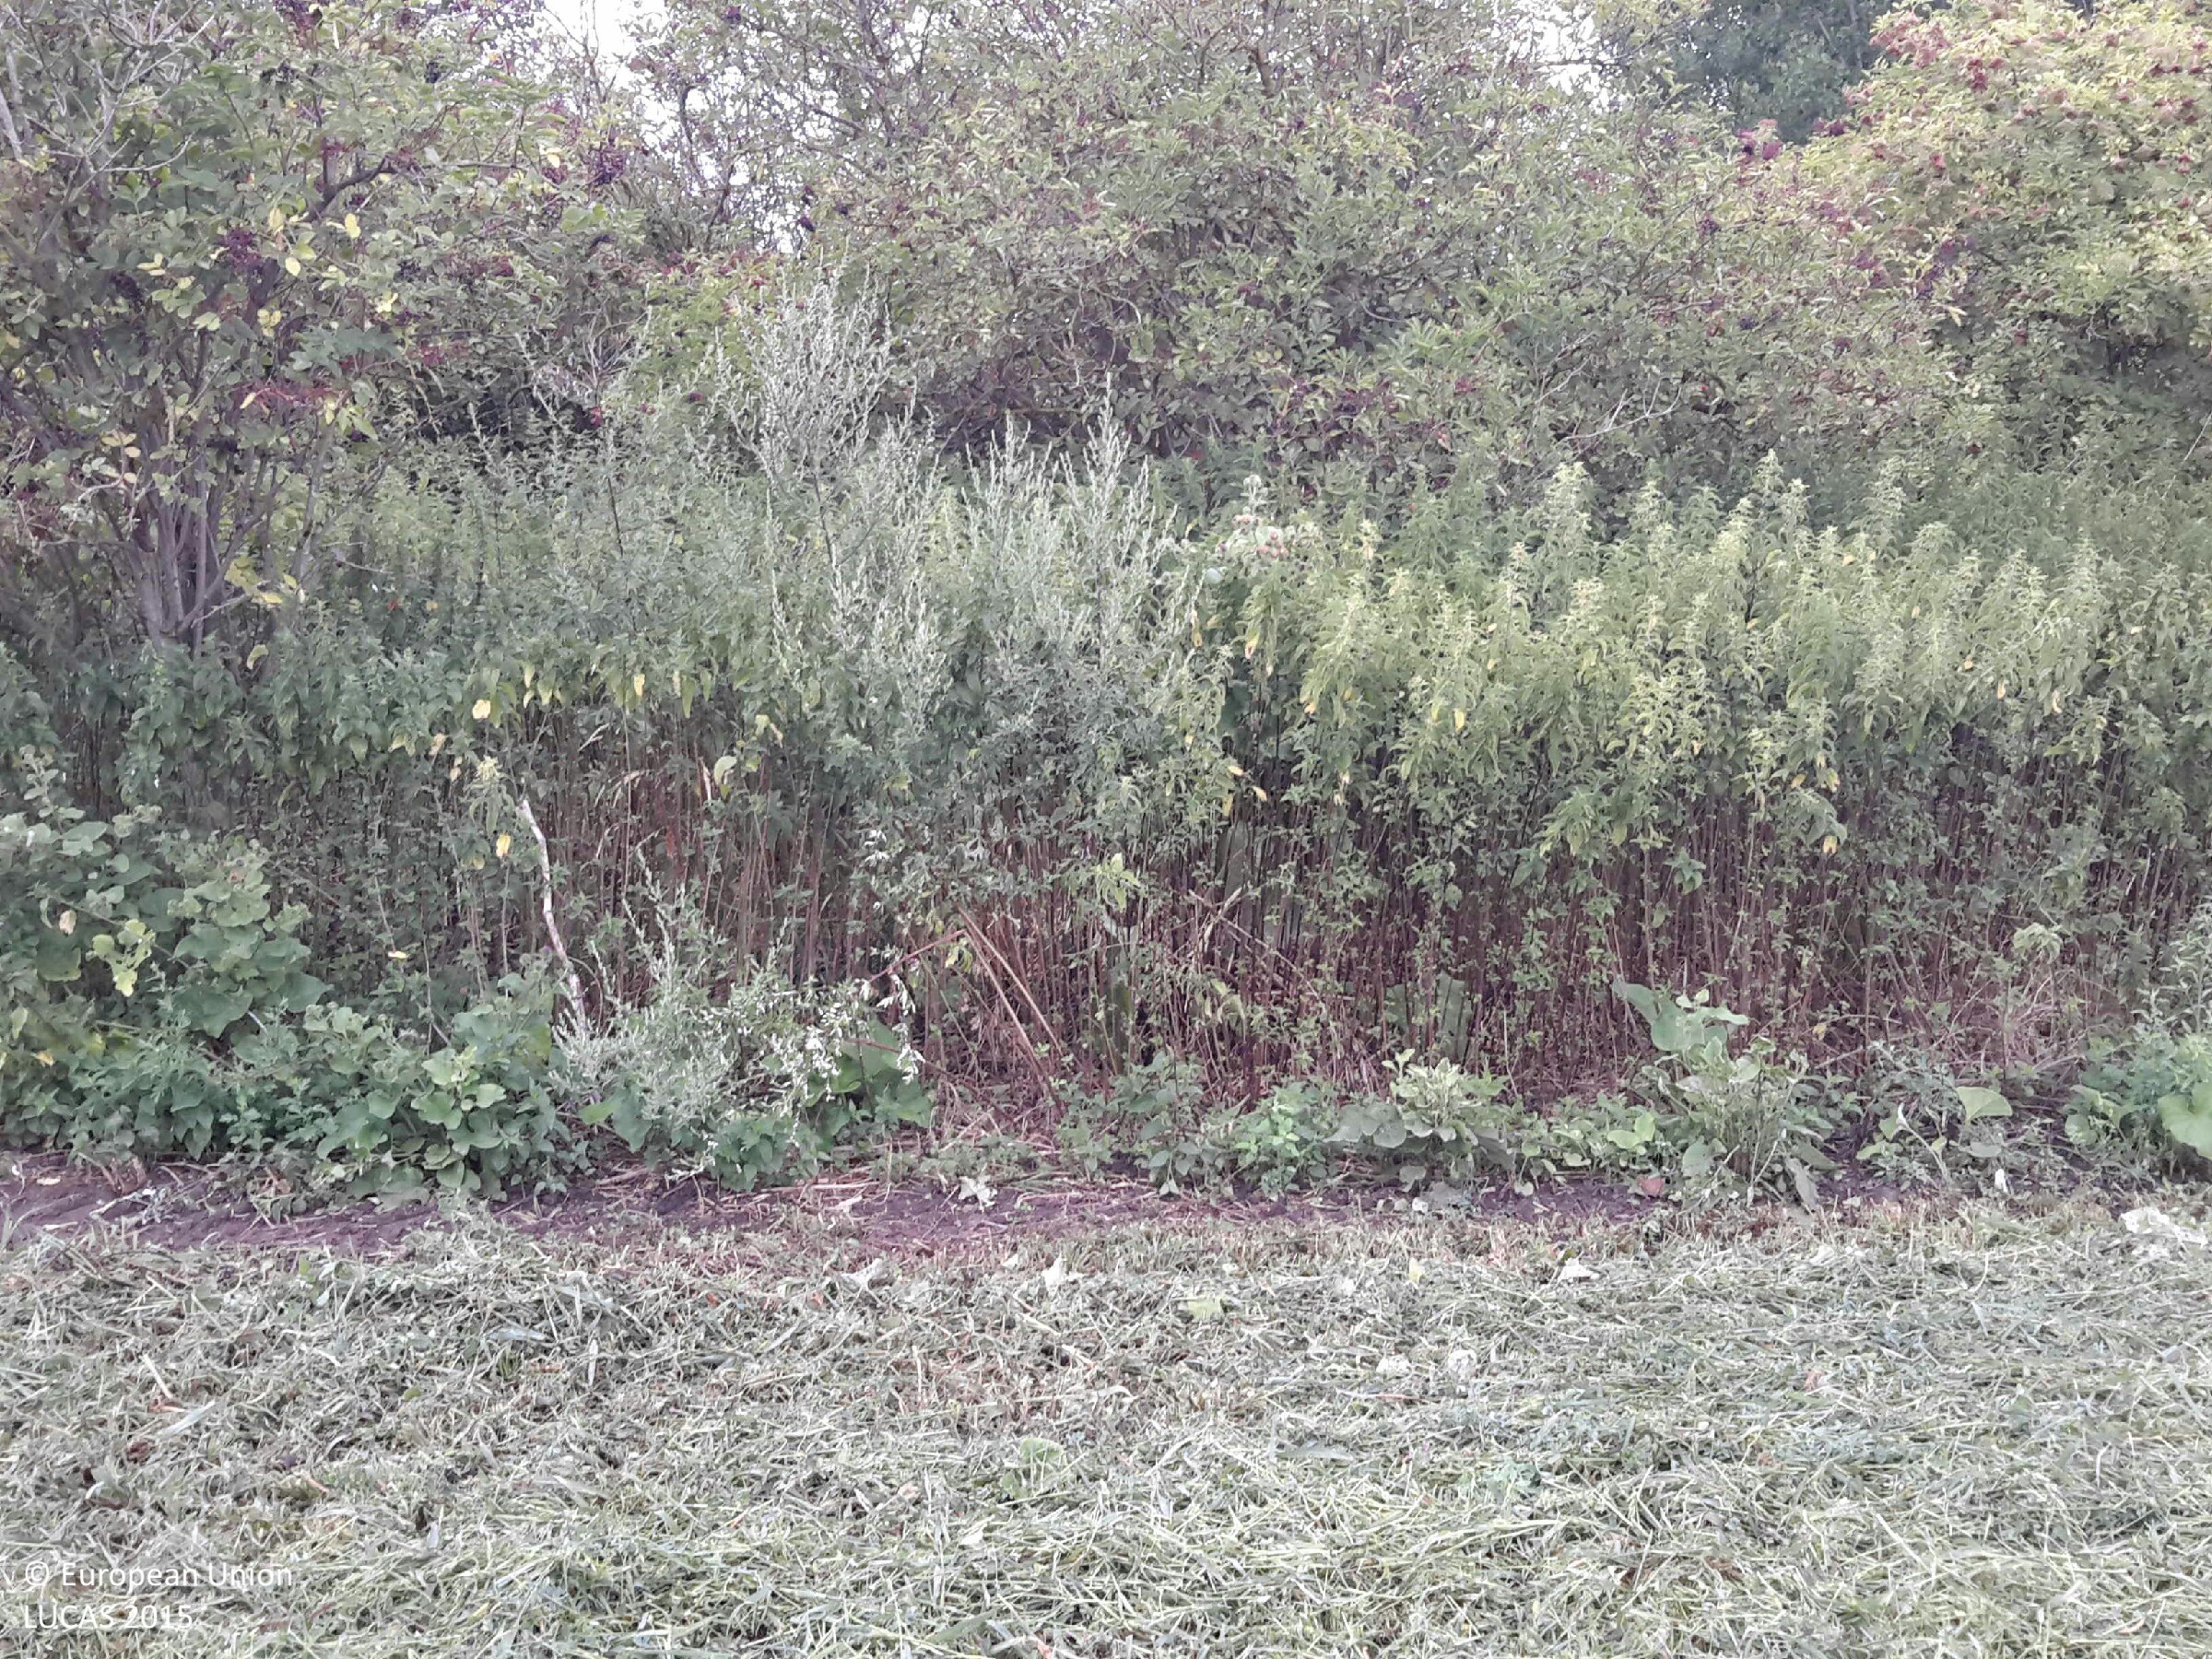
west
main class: Cropland
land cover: Lucerne
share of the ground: > 75 %
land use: Agriculture (excluding fallow land and kitchen gardens)
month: July
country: HU
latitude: 47.5082
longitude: 17.3497
